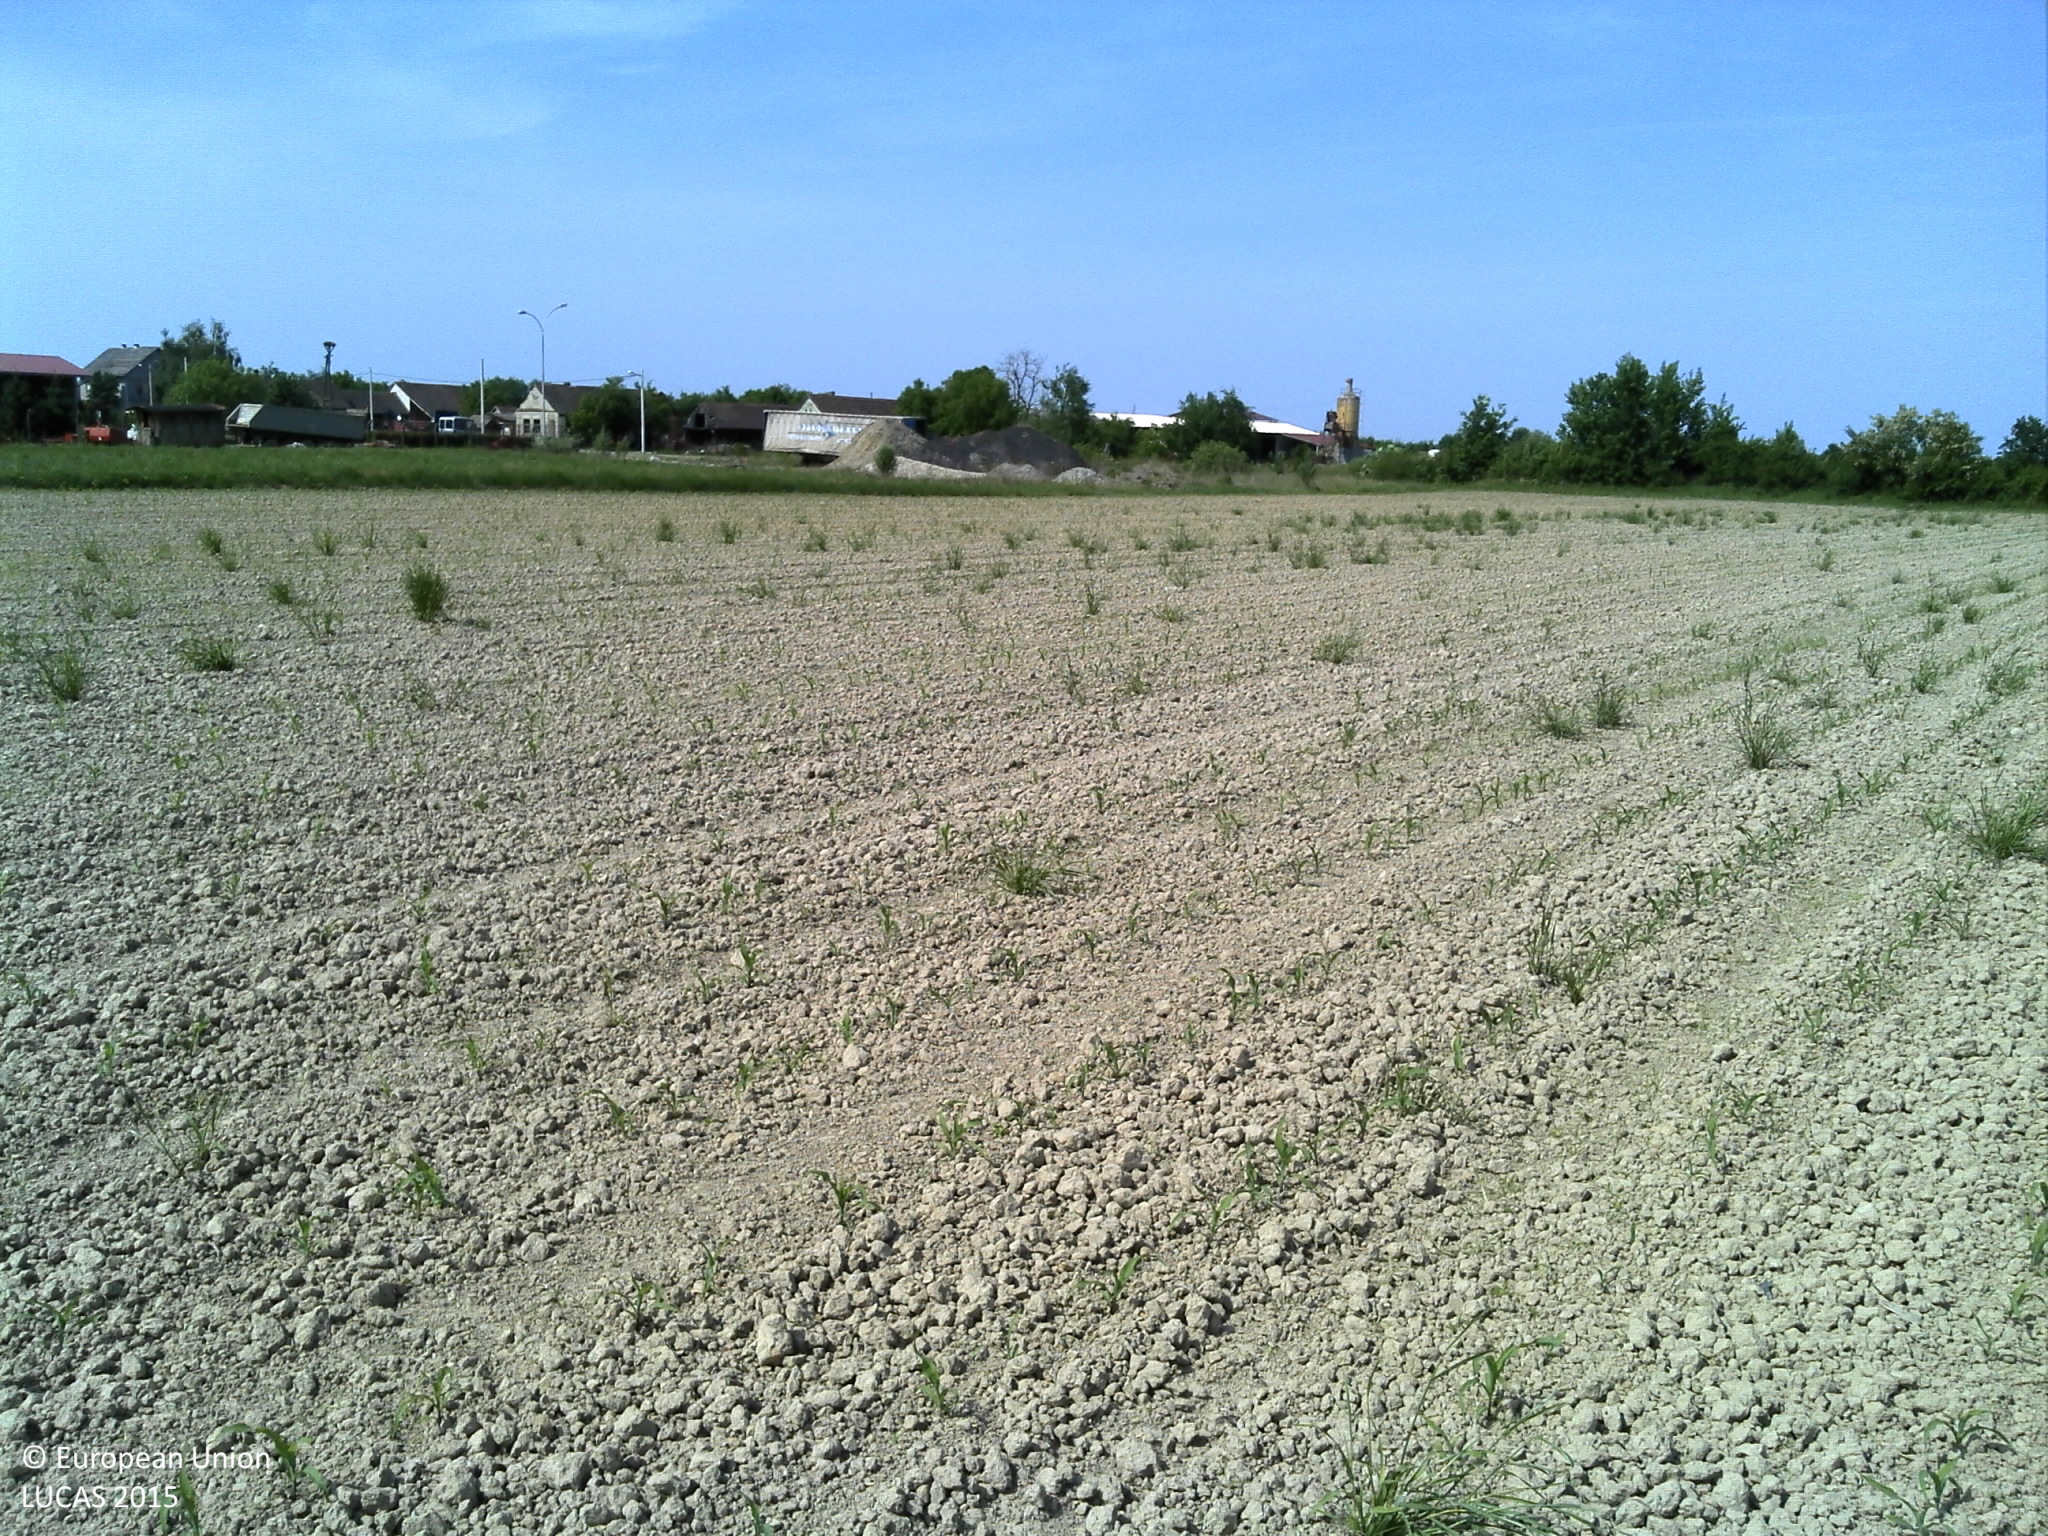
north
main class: Cropland
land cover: Maize
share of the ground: < 10 %
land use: Agriculture (excluding fallow land and kitchen gardens)
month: May
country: HR
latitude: 45.5757
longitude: 18.0649
